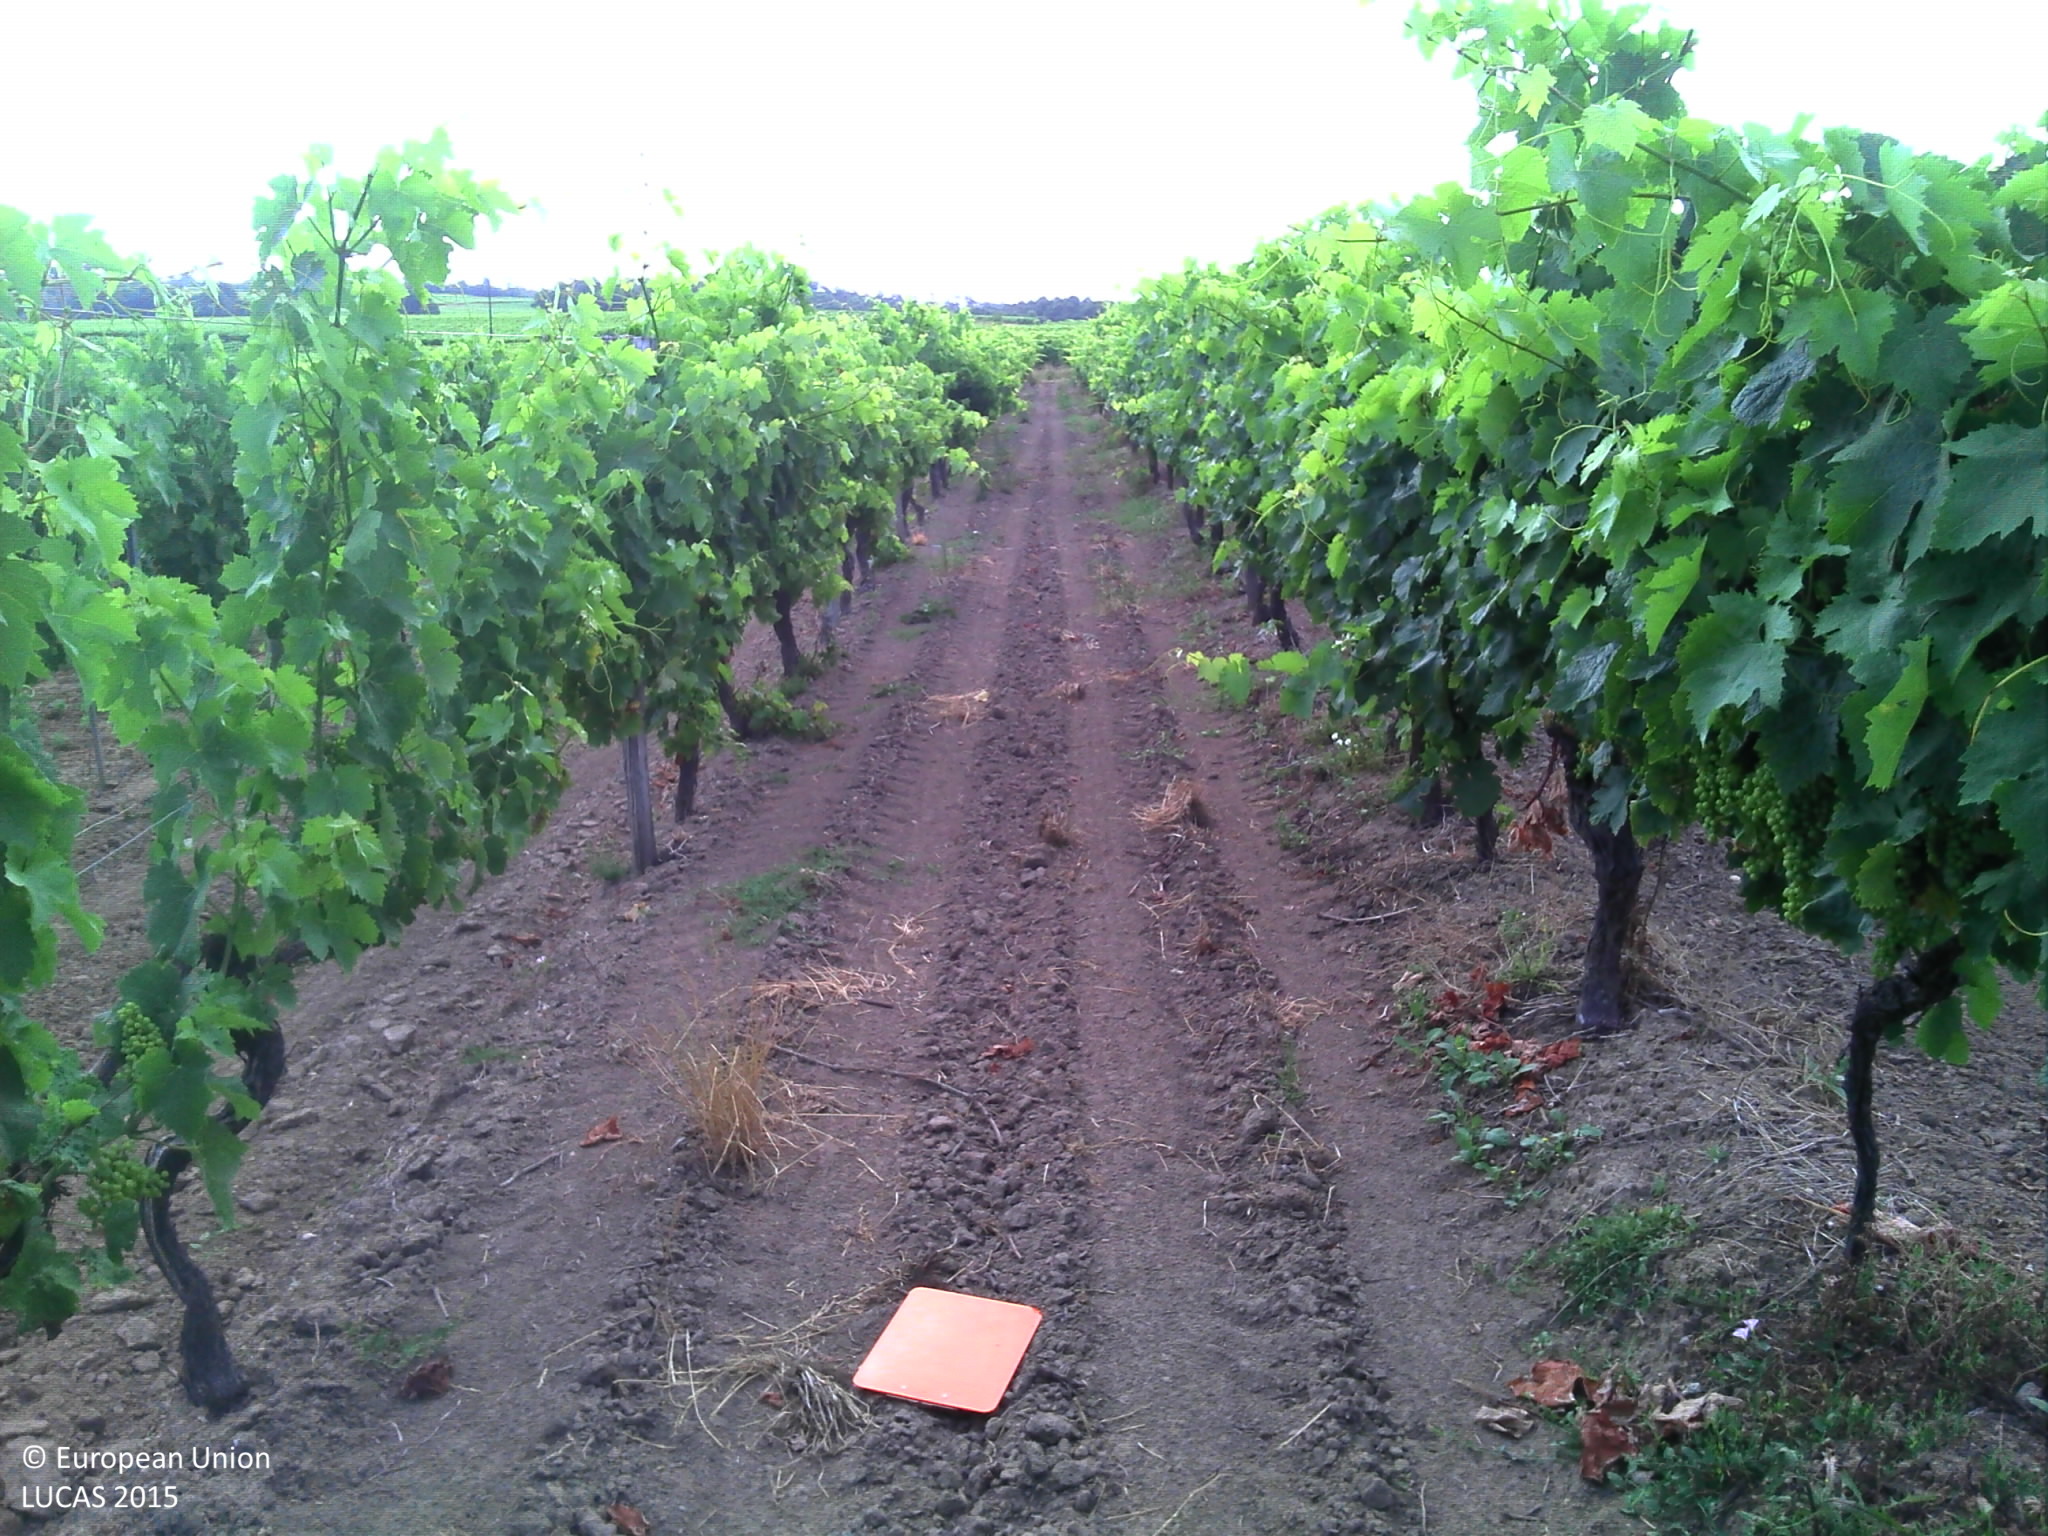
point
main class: Cropland
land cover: Vineyards
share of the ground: 50 - 75 %
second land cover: Other bare soil
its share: > 75 %
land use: Agriculture (excluding fallow land and kitchen gardens)
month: July
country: FR
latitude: 45.3301
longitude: -0.6248
